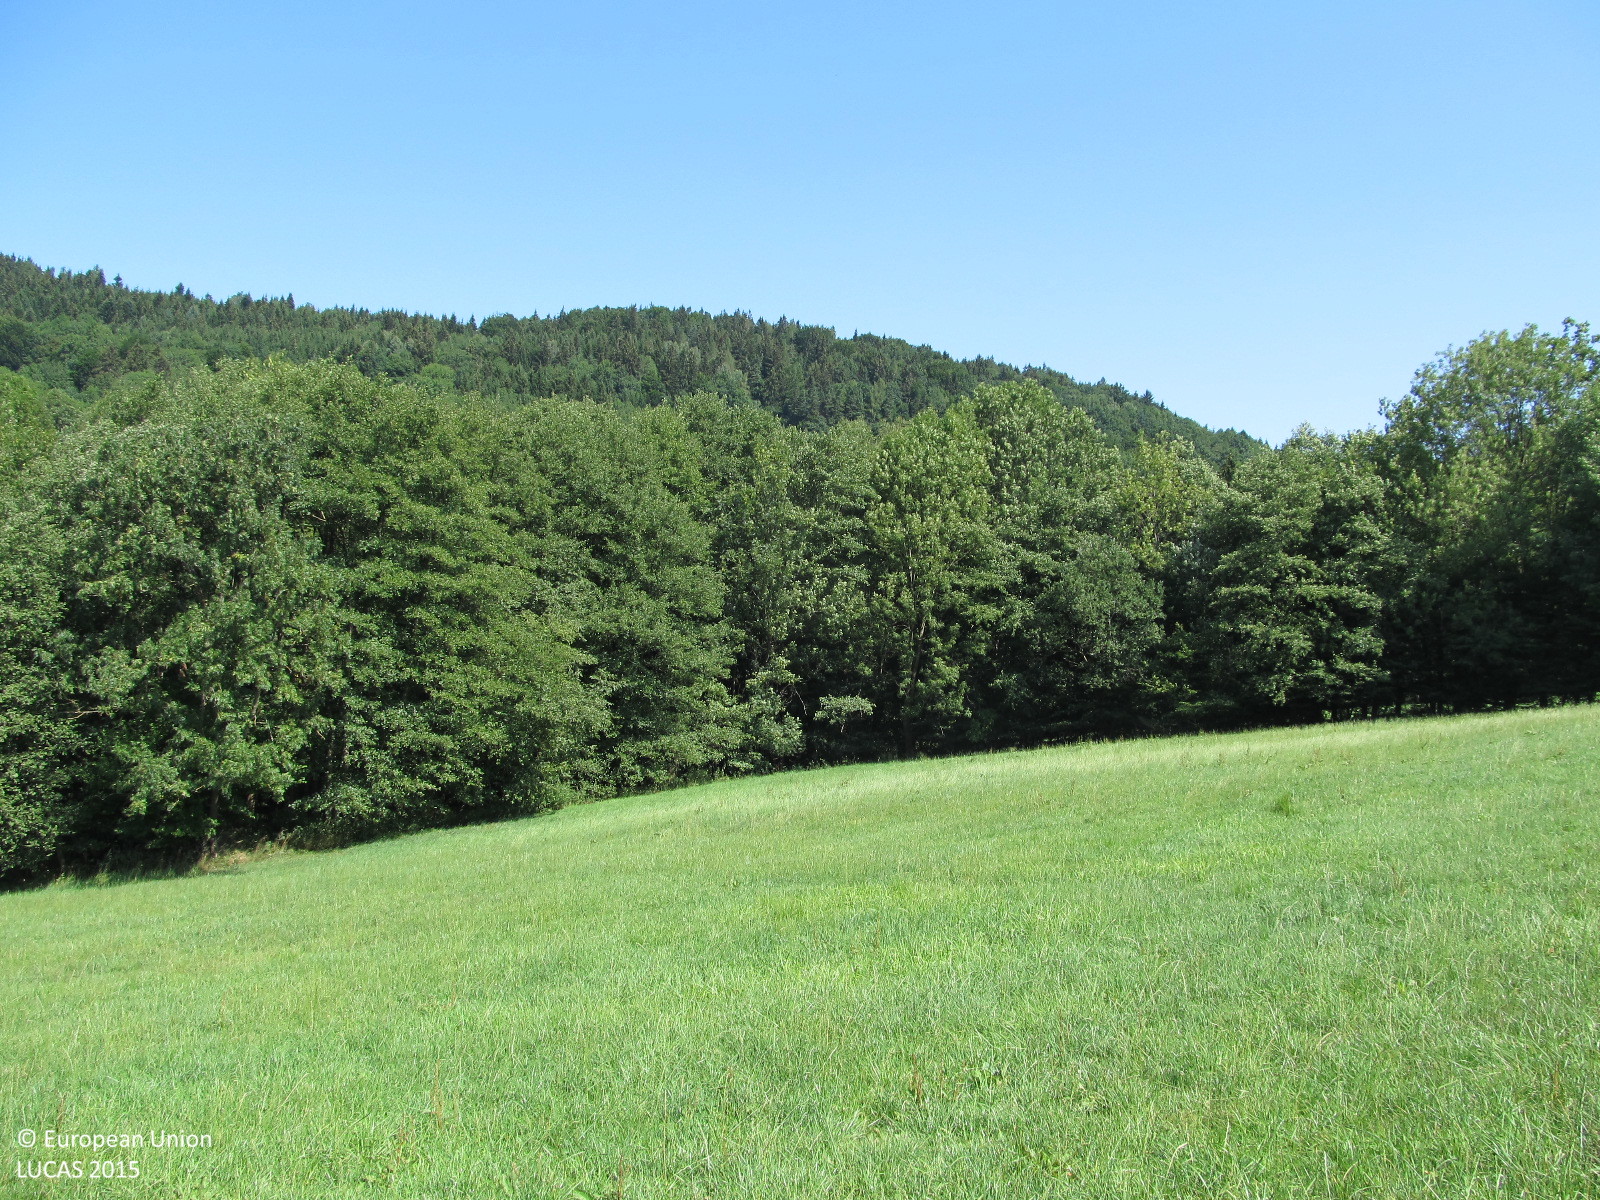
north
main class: Grassland
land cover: Grassland without tree/shrub cover
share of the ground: > 75 %
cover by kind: herbaceous plants 100 %
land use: Agriculture (excluding fallow land and kitchen gardens)
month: August
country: AT
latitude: 48.0729
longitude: 15.7606
